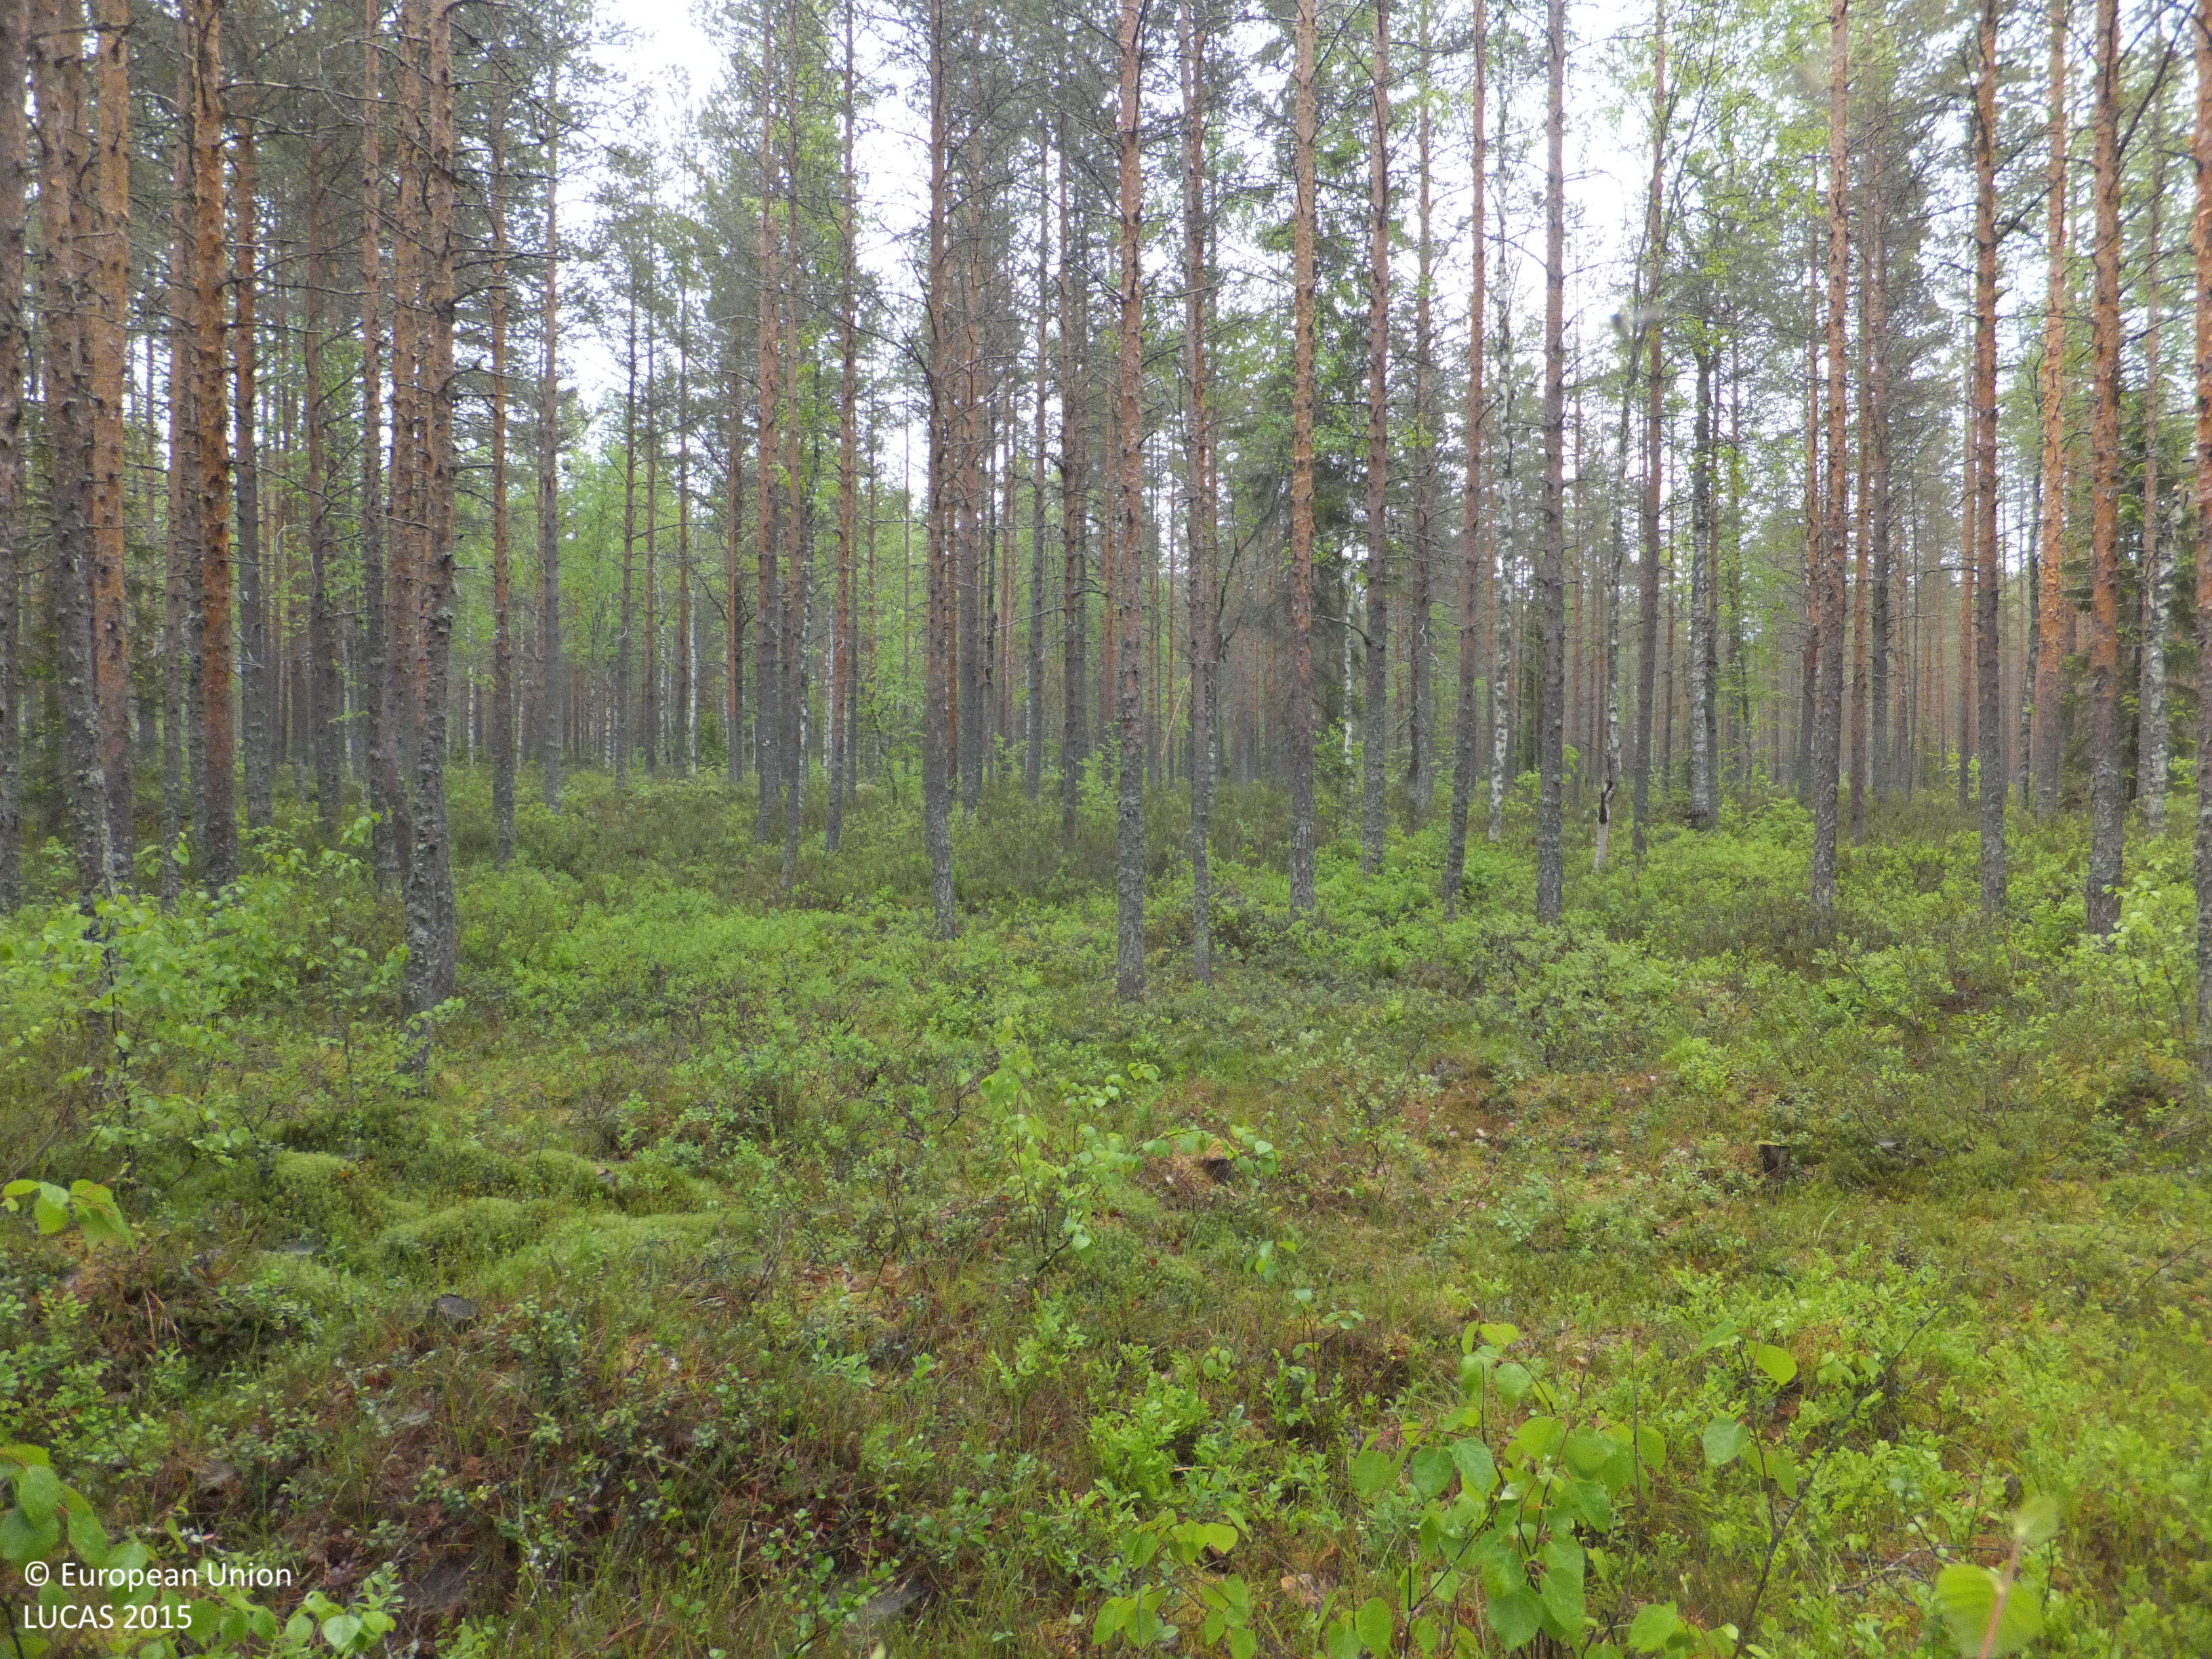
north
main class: Woodland
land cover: Pine dominated coniferous woodland
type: boreal forest
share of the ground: > 75 %
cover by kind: coniferous forest trees 75 %, shrubs 15 %, broadleaved forest trees 5 %, lichens and mosses 5 %
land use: Forestry
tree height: > 5 m
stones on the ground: < 10 %
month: June
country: FI
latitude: 63.5151
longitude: 24.9826
